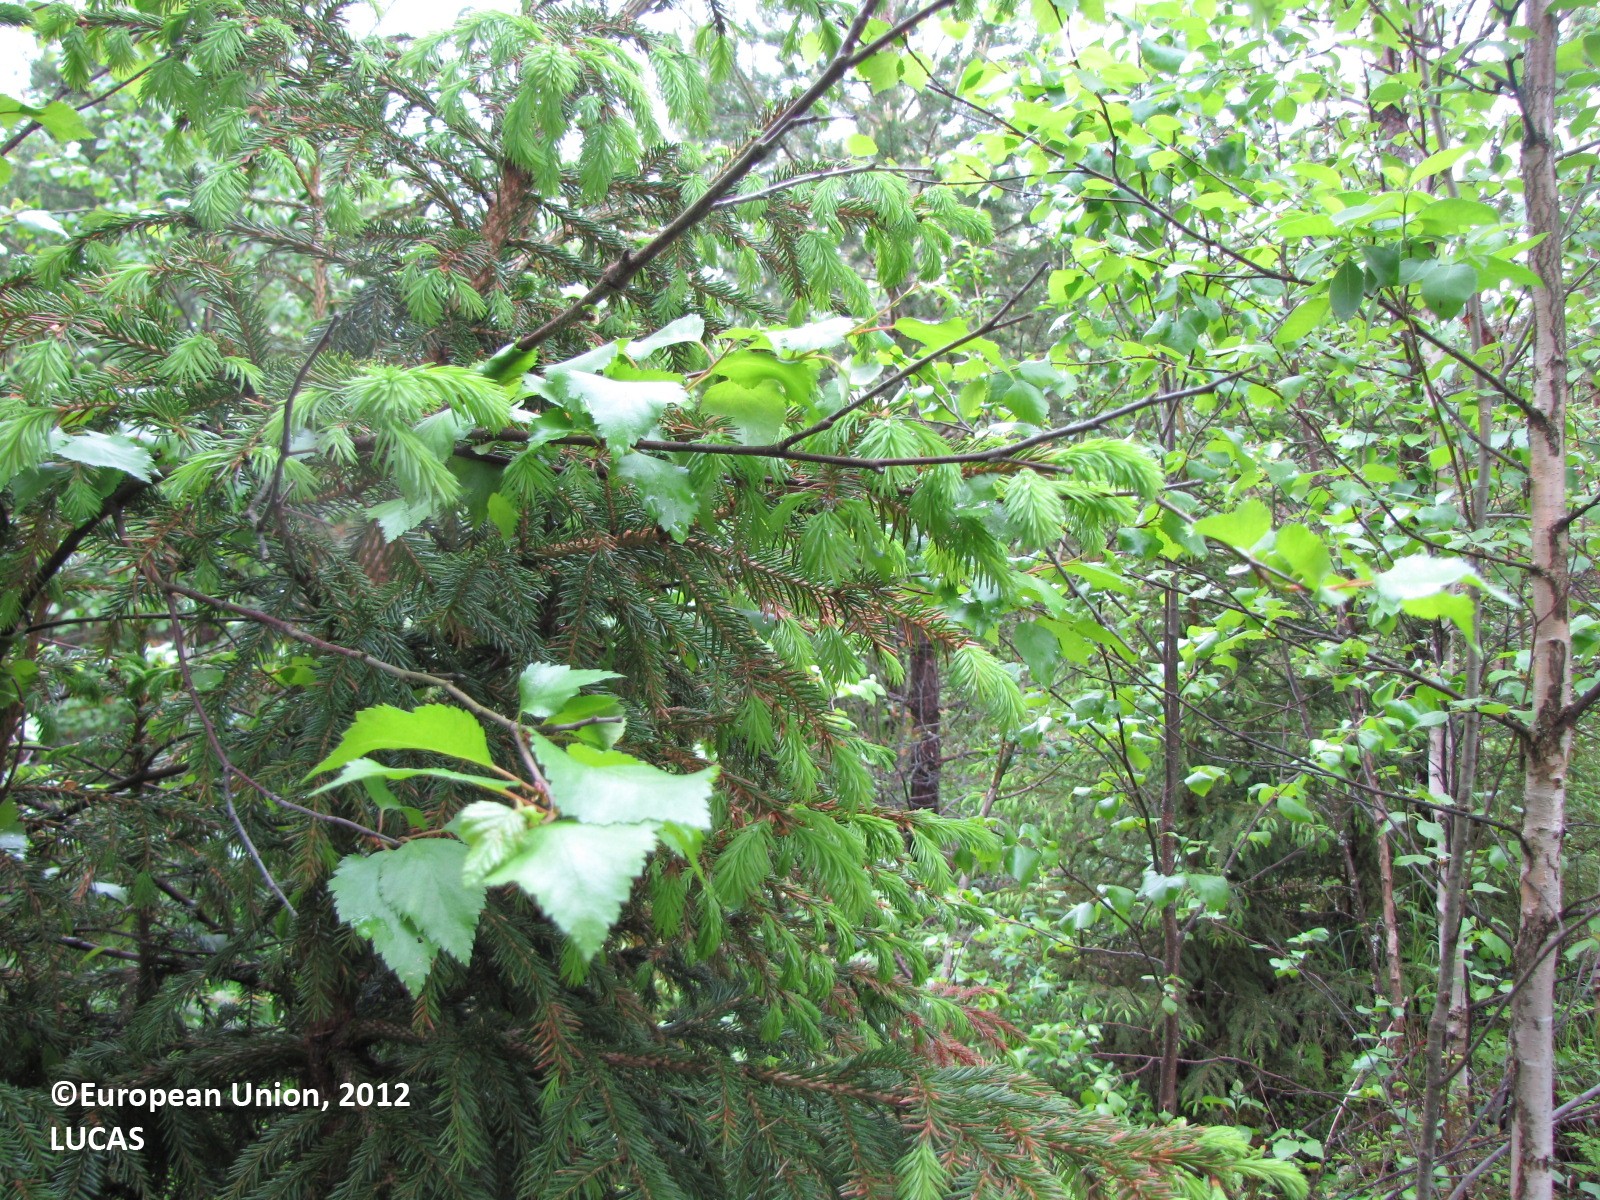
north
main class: Woodland
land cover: Other mixed woodland
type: boreal forest
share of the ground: > 75 %
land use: Forestry
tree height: > 5 m
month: June
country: FI
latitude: 66.0020
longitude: 24.4389
